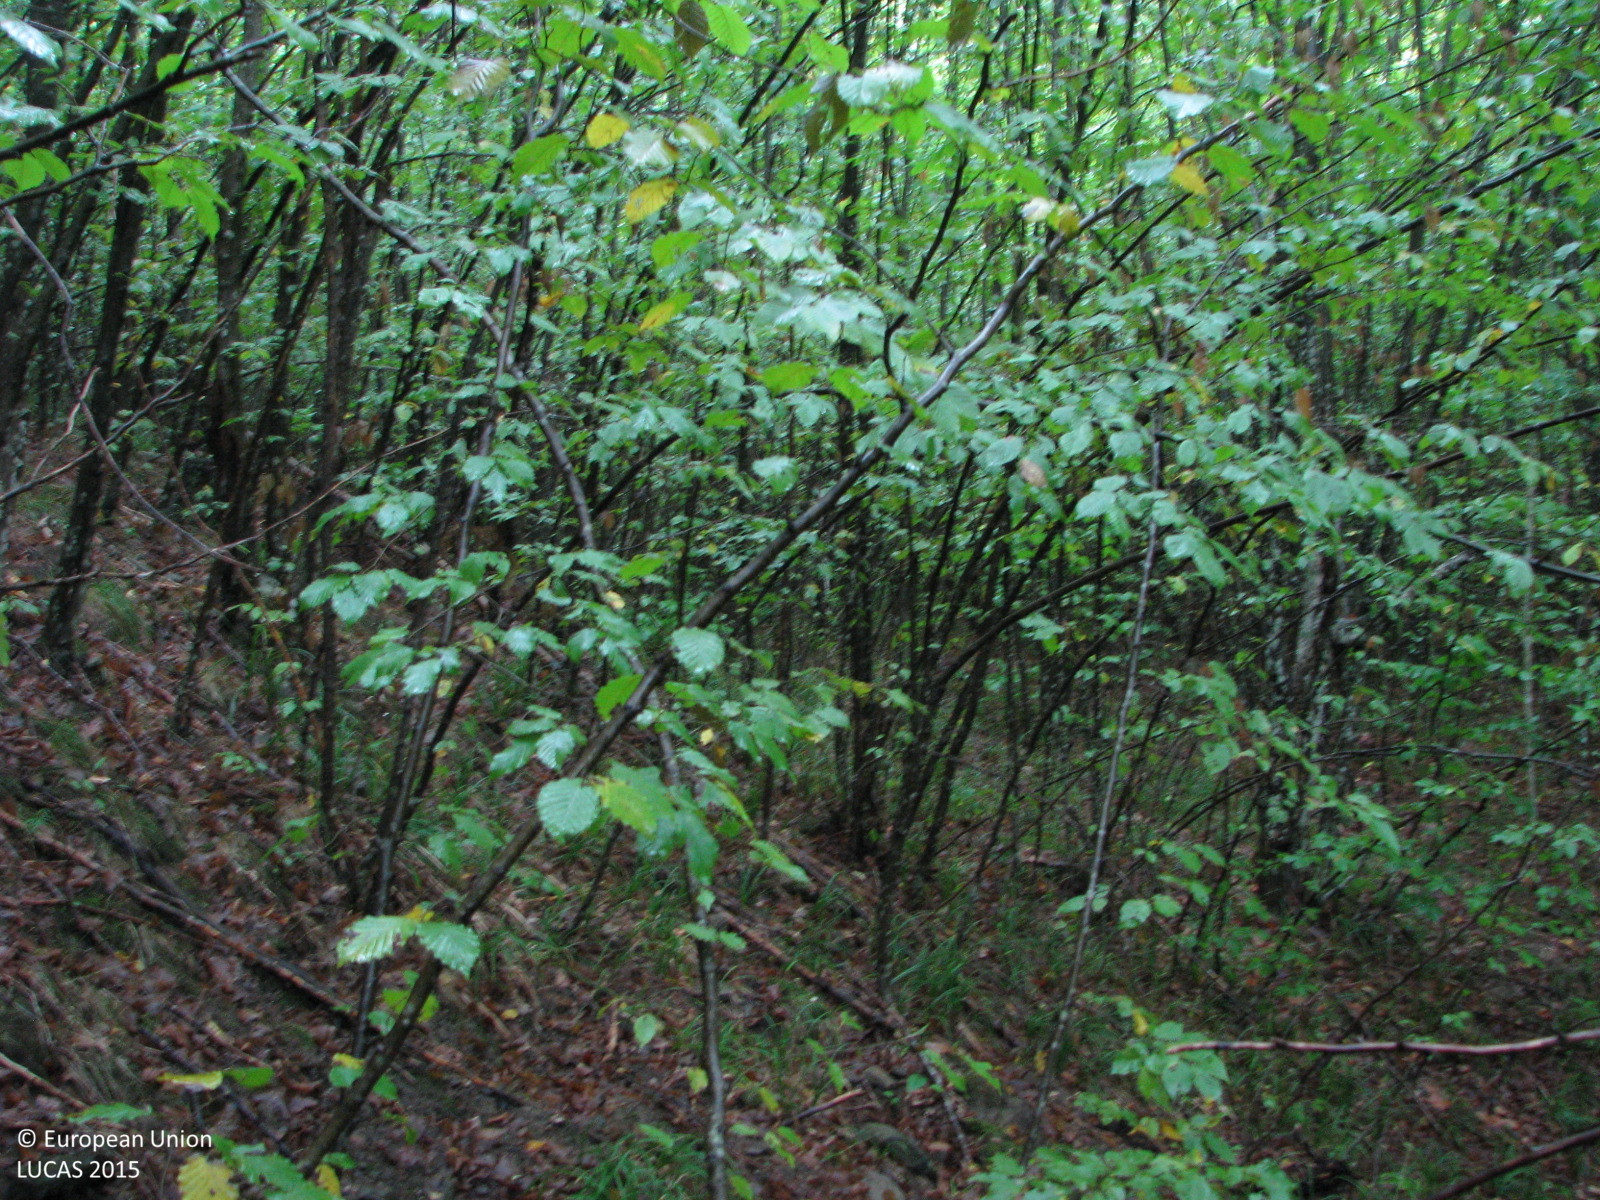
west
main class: Woodland
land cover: Broadleaved woodland
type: mesophytic deciduous forest
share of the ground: > 75 %
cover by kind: broadleaved forest trees 100 %
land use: Forestry
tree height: > 5 m
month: September
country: BG
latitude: 42.9282
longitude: 26.3784
